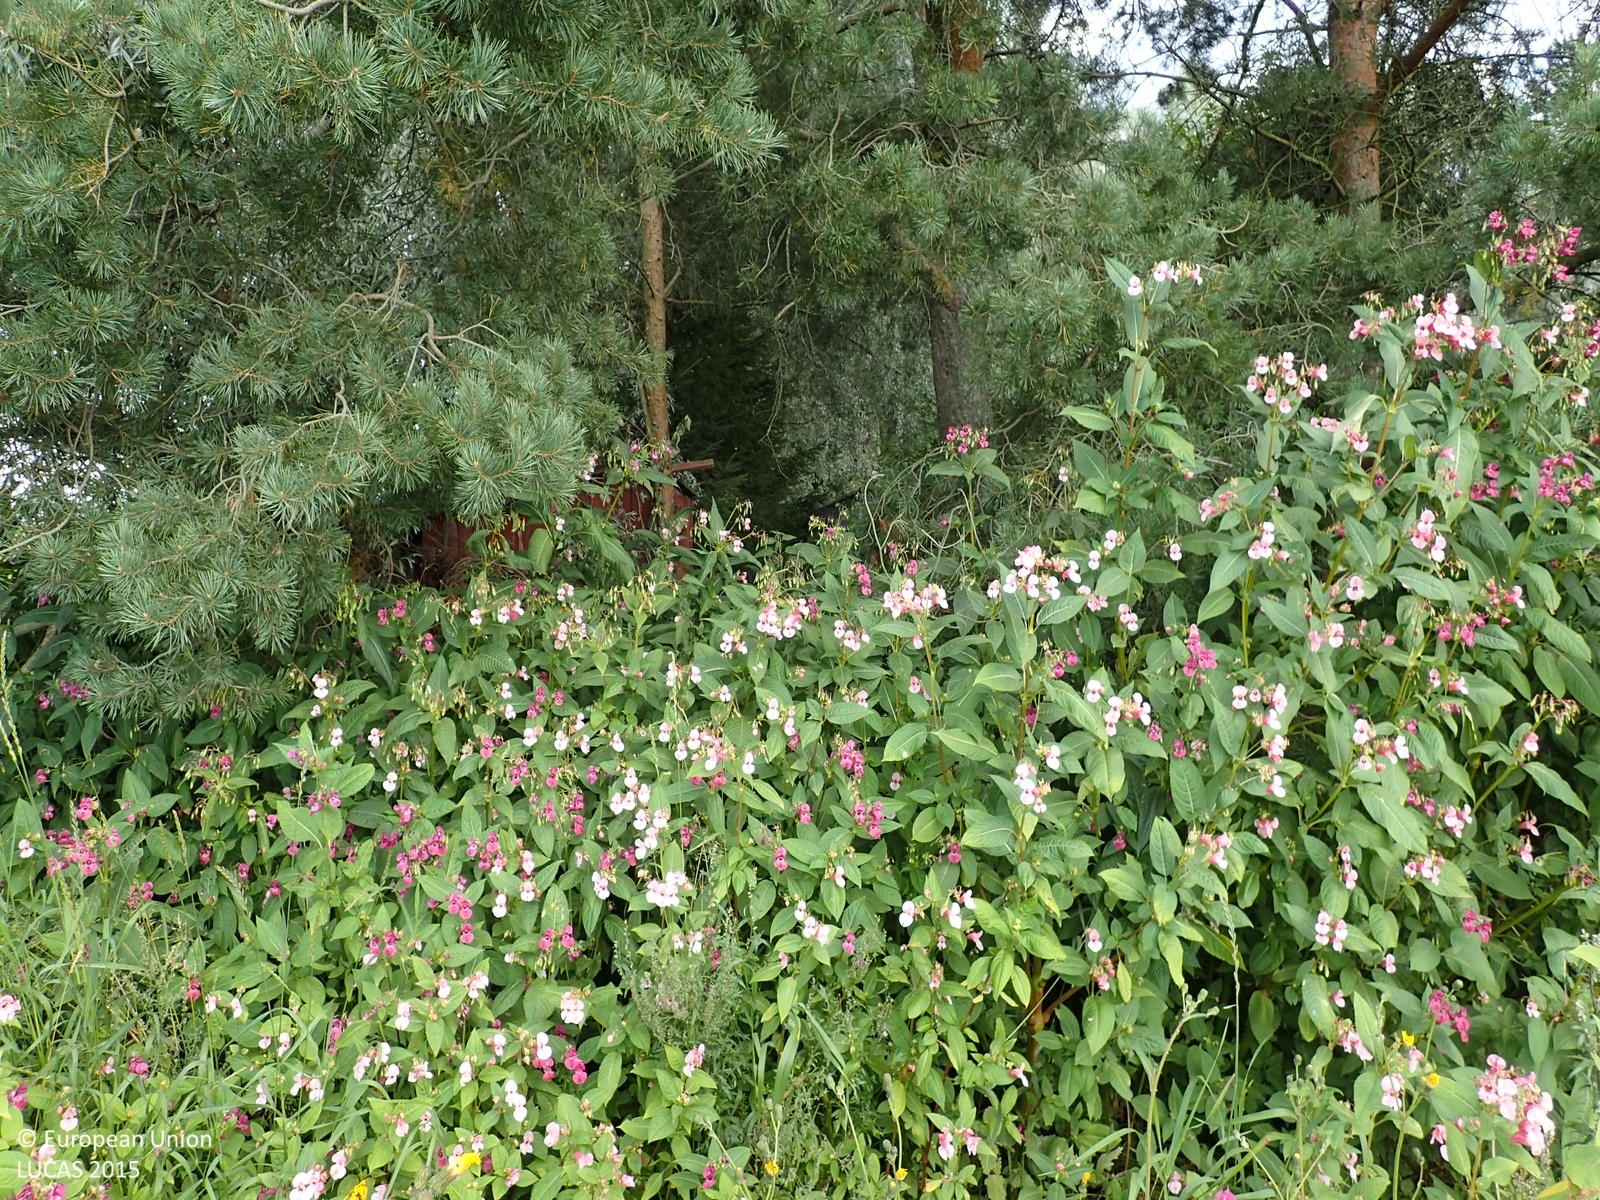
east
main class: Woodland
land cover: Pine dominated mixed woodland
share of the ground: > 75 %
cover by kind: broadleaved forest trees 60 %, coniferous forest trees 30 %, herbaceous plants 10 %
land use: Residential
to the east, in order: Pine dominated mixed woodland; Broadleaved woodland; Shruby margins; Ditches and canals; Barley
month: August
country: FI
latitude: 62.7396
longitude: 22.5993
